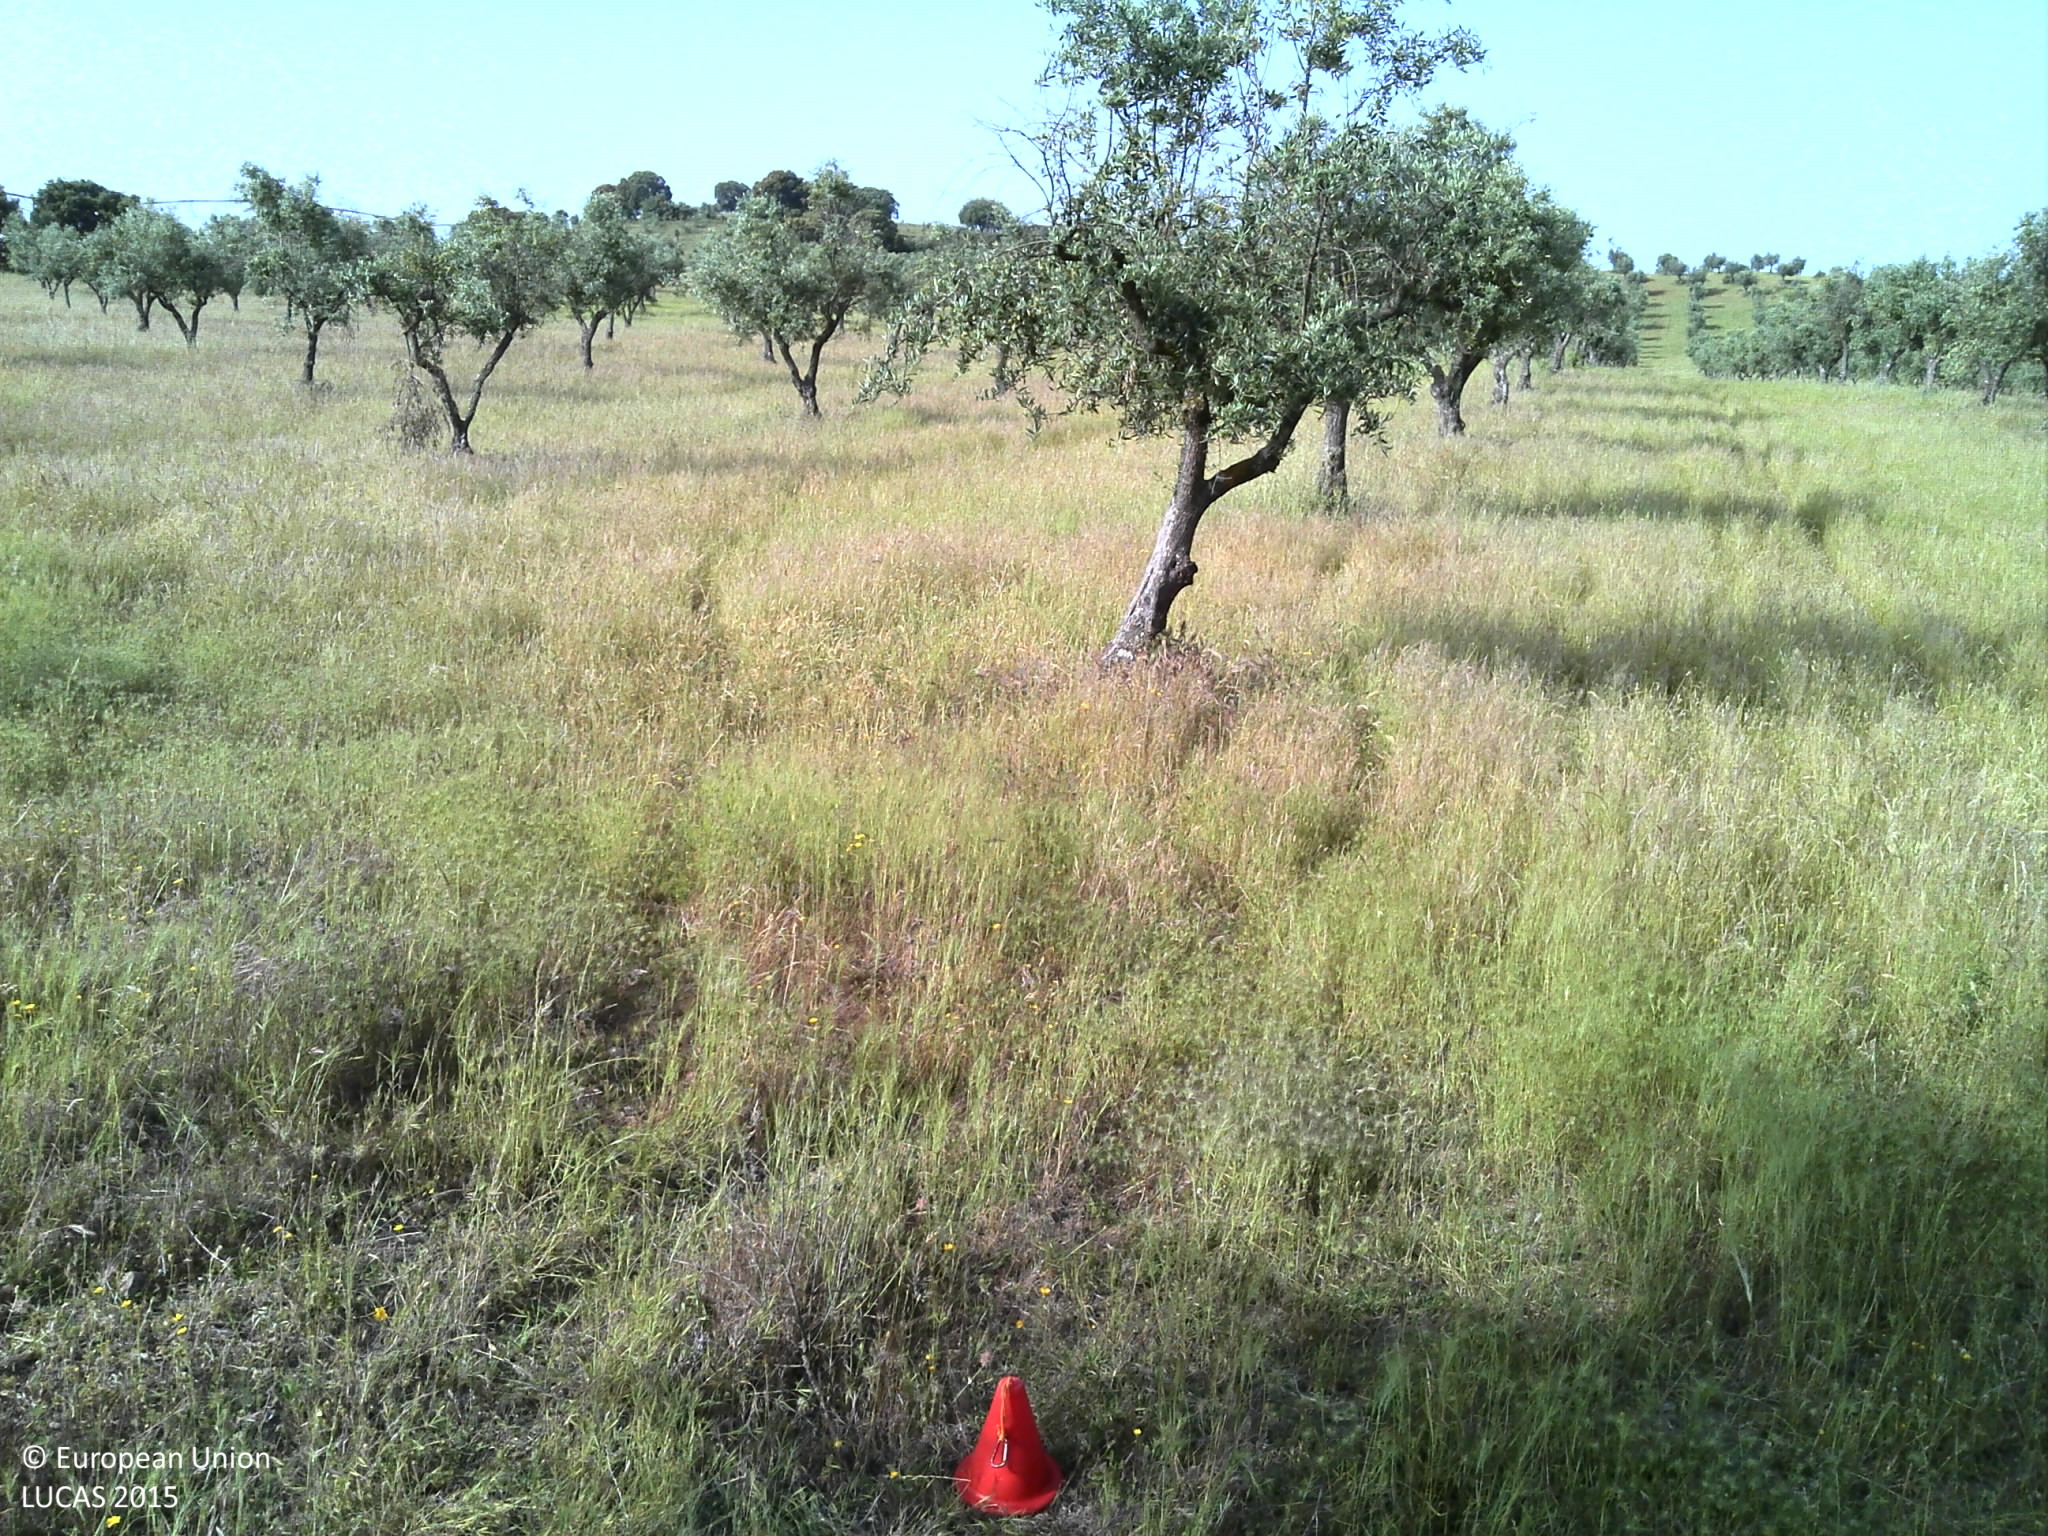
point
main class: Cropland
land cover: Olive groves
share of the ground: 25 - 50 %
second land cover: Grassland without tree/shrub cover
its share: 50 - 75 %
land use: Agriculture (excluding fallow land and kitchen gardens)
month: May
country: PT
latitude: 39.0136
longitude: -7.7958
